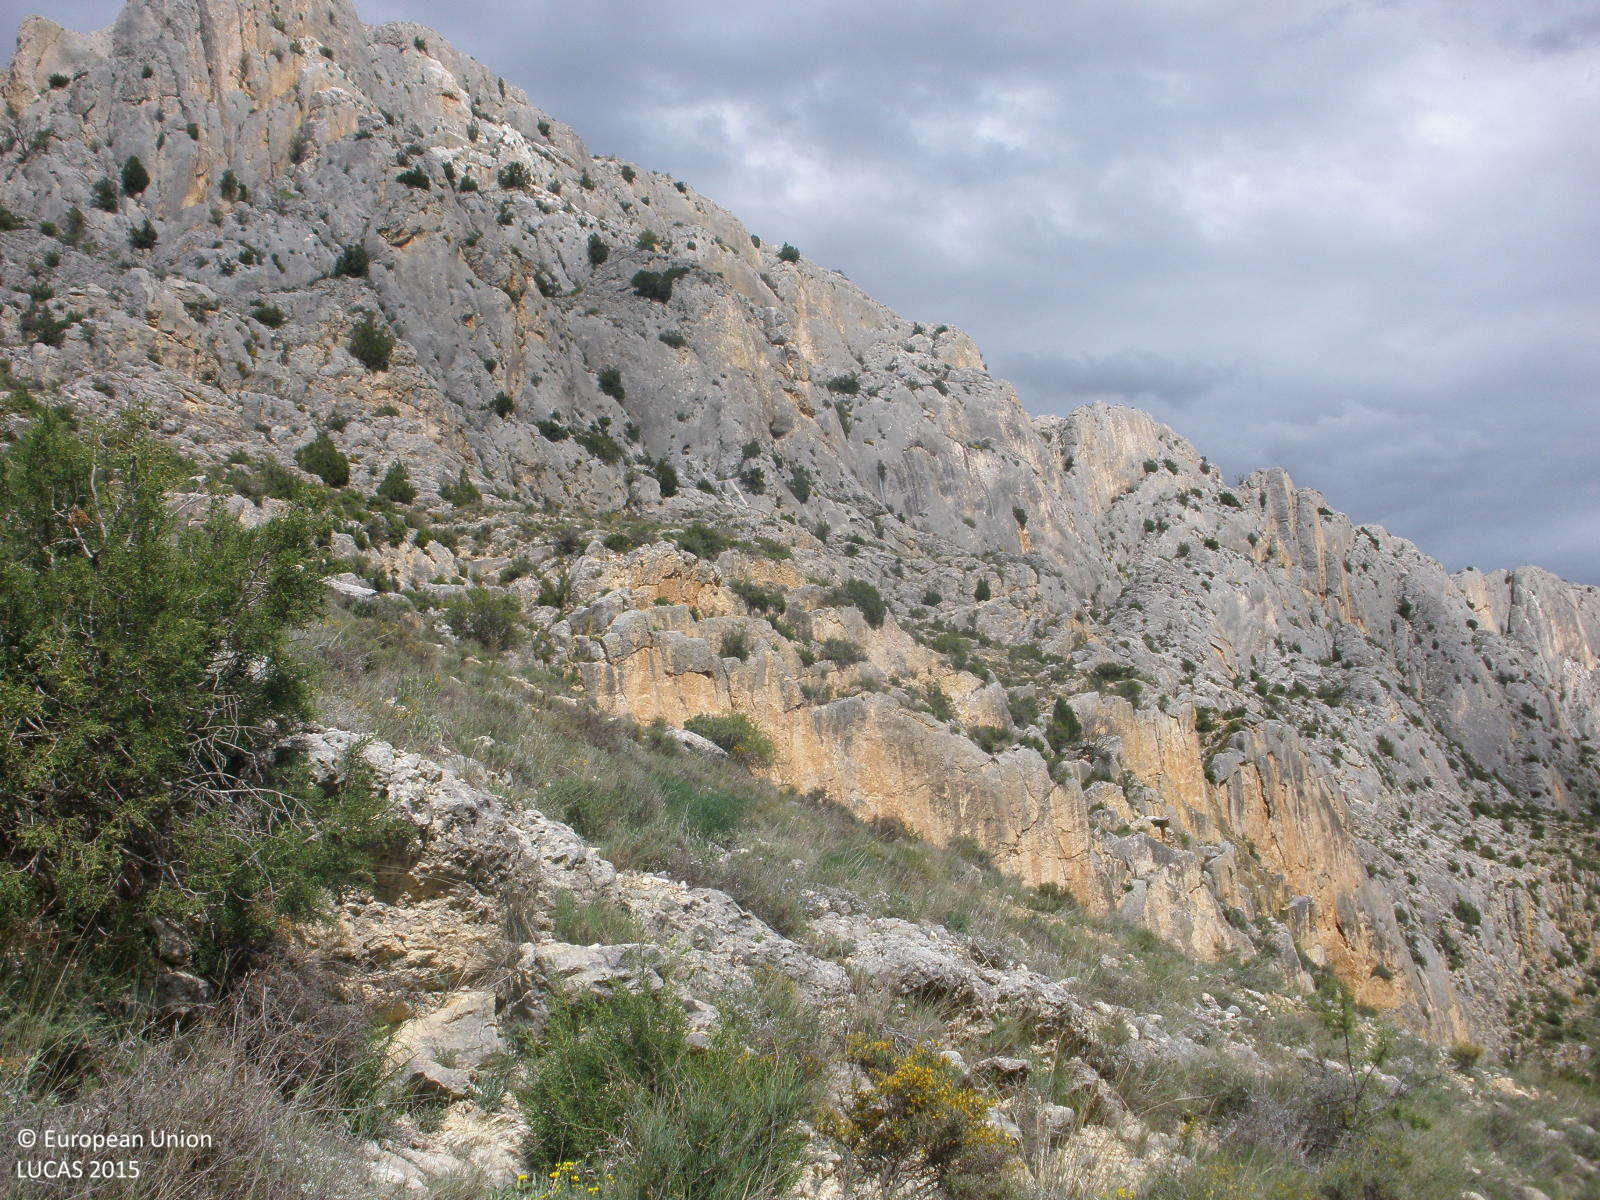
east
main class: Shrubland
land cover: Shrubland without tree cover
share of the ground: > 75 %
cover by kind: shrubs 70 %, herbaceous plants 15 %, consolidated bare surface 15 %
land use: Semi-natural and natural areas not in use
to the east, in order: Shrubland without tree cover; Rocks and stones; Shrubland without tree cover
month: May
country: ES
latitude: 41.0054
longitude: -0.9186
